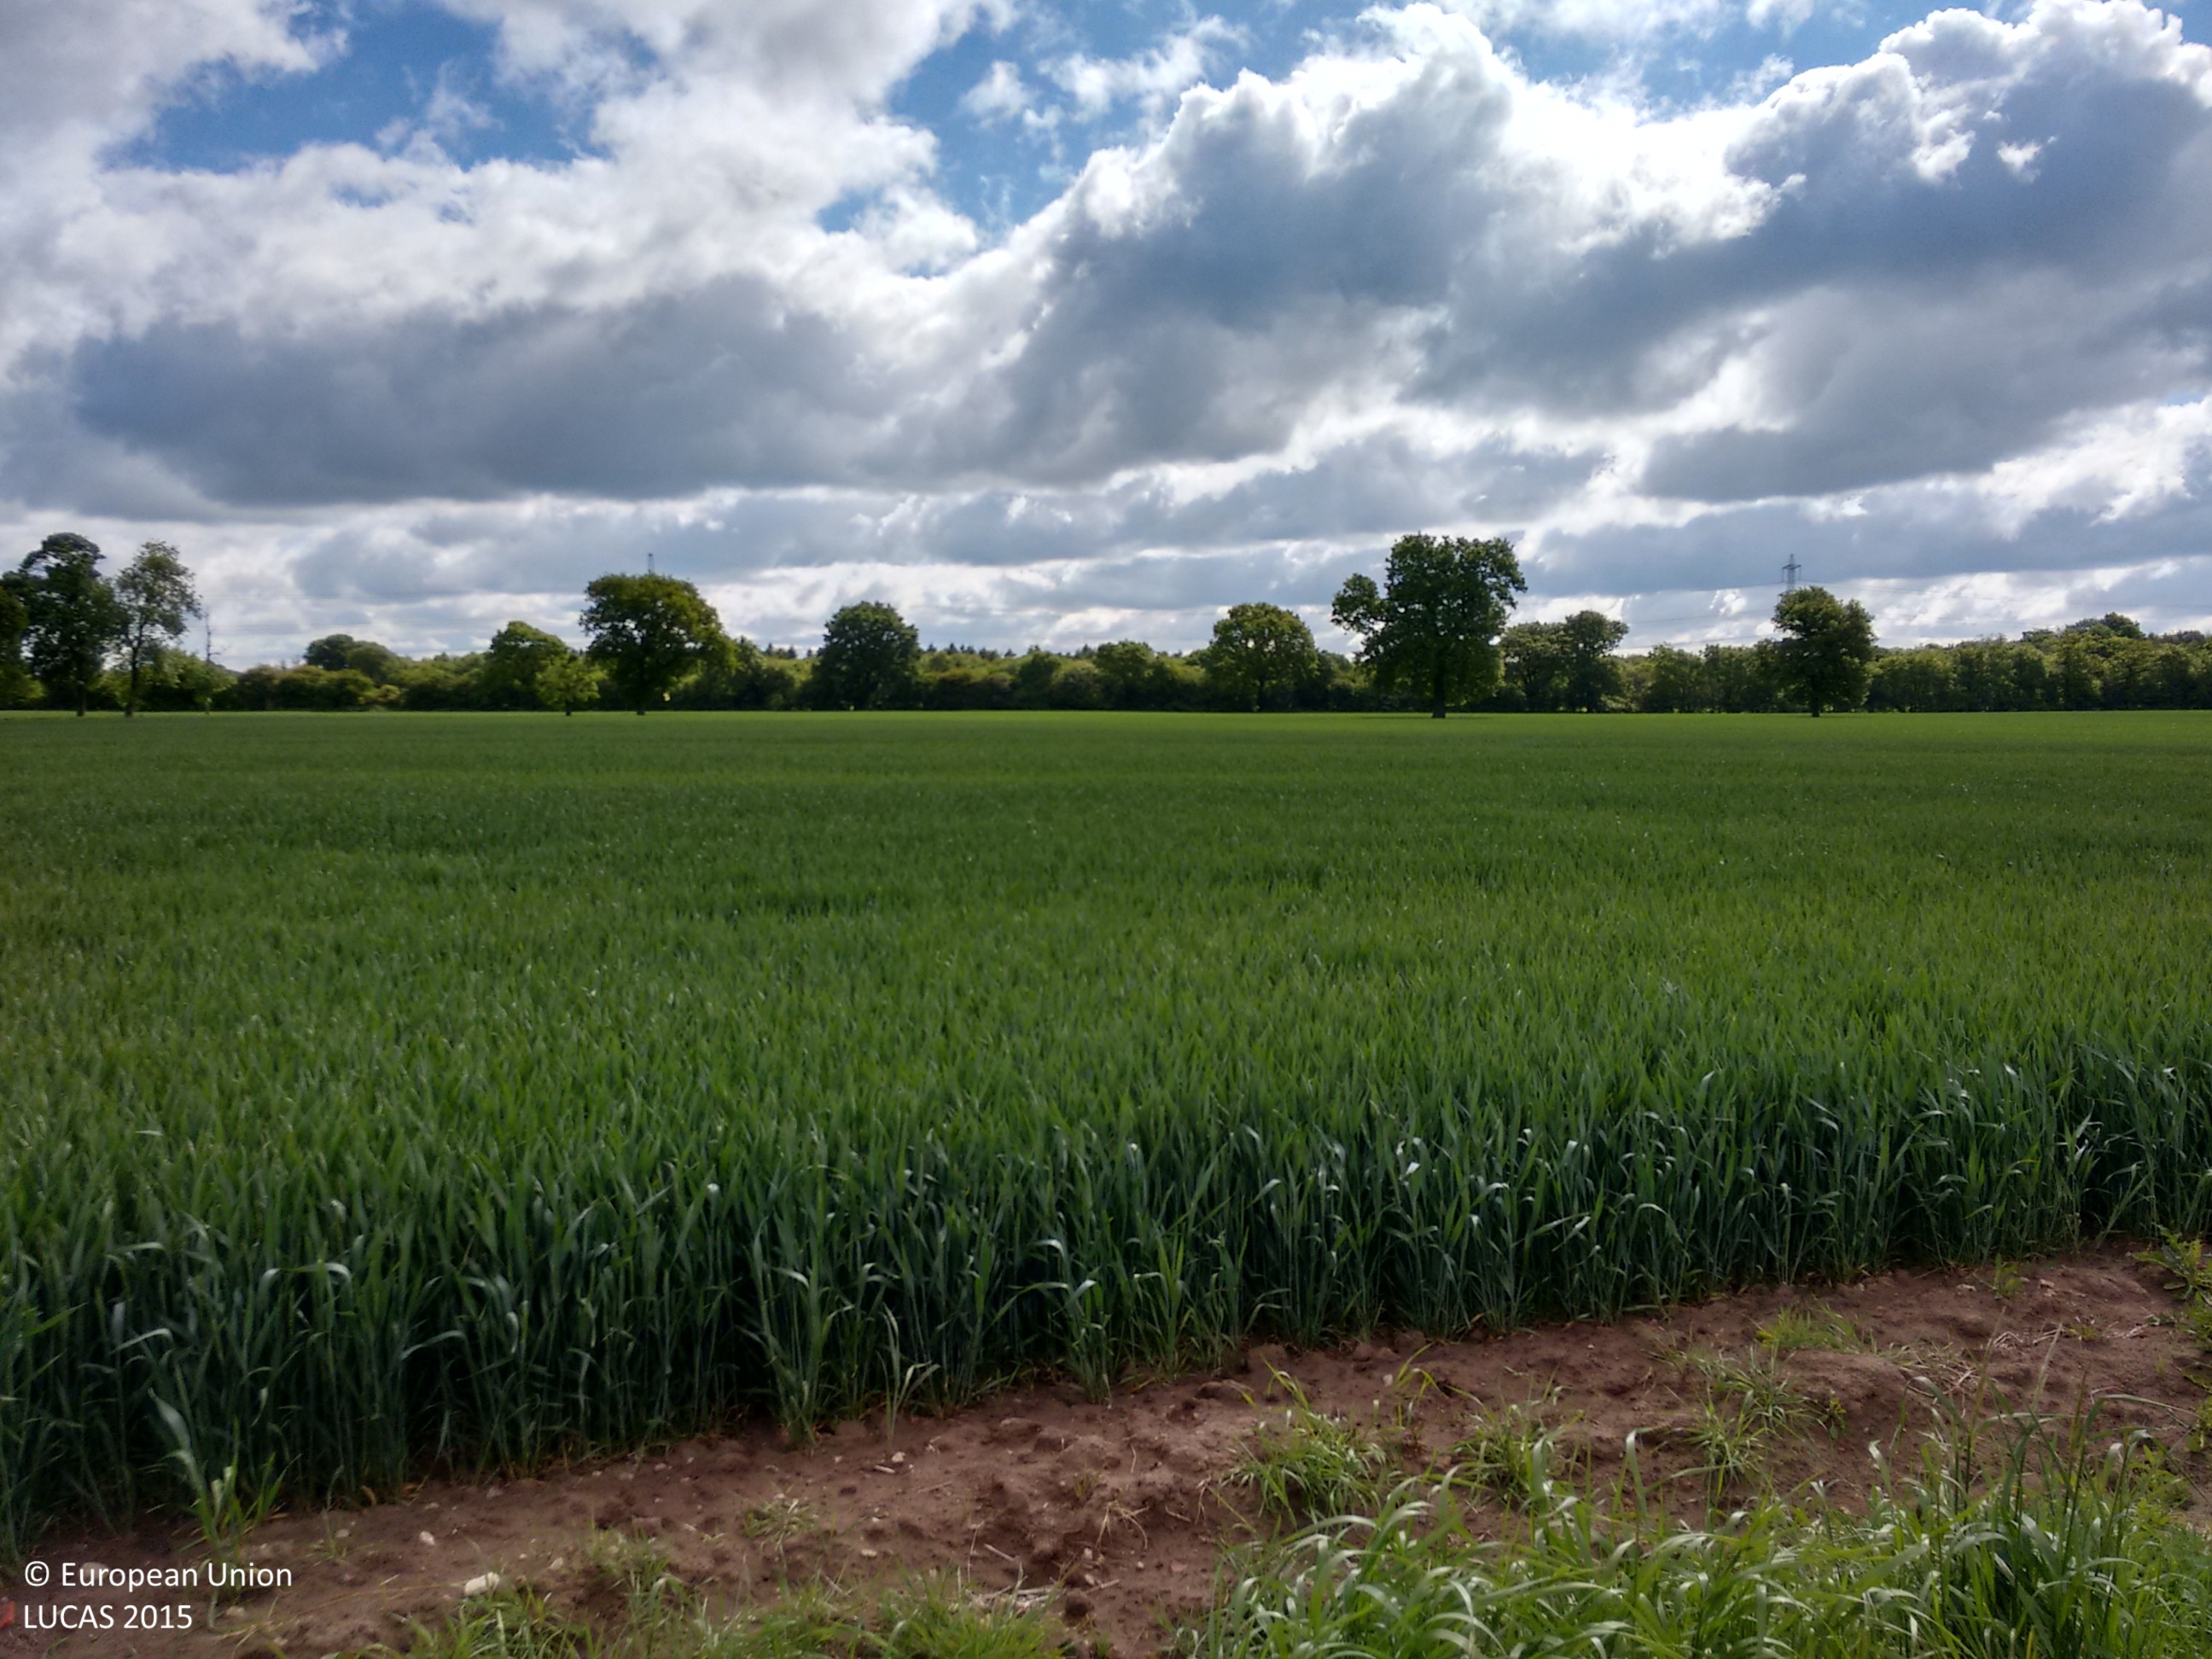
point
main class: Cropland
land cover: Common wheat
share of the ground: > 75 %
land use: Agriculture (excluding fallow land and kitchen gardens)
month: June
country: GB
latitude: 54.0652
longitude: -1.1528
